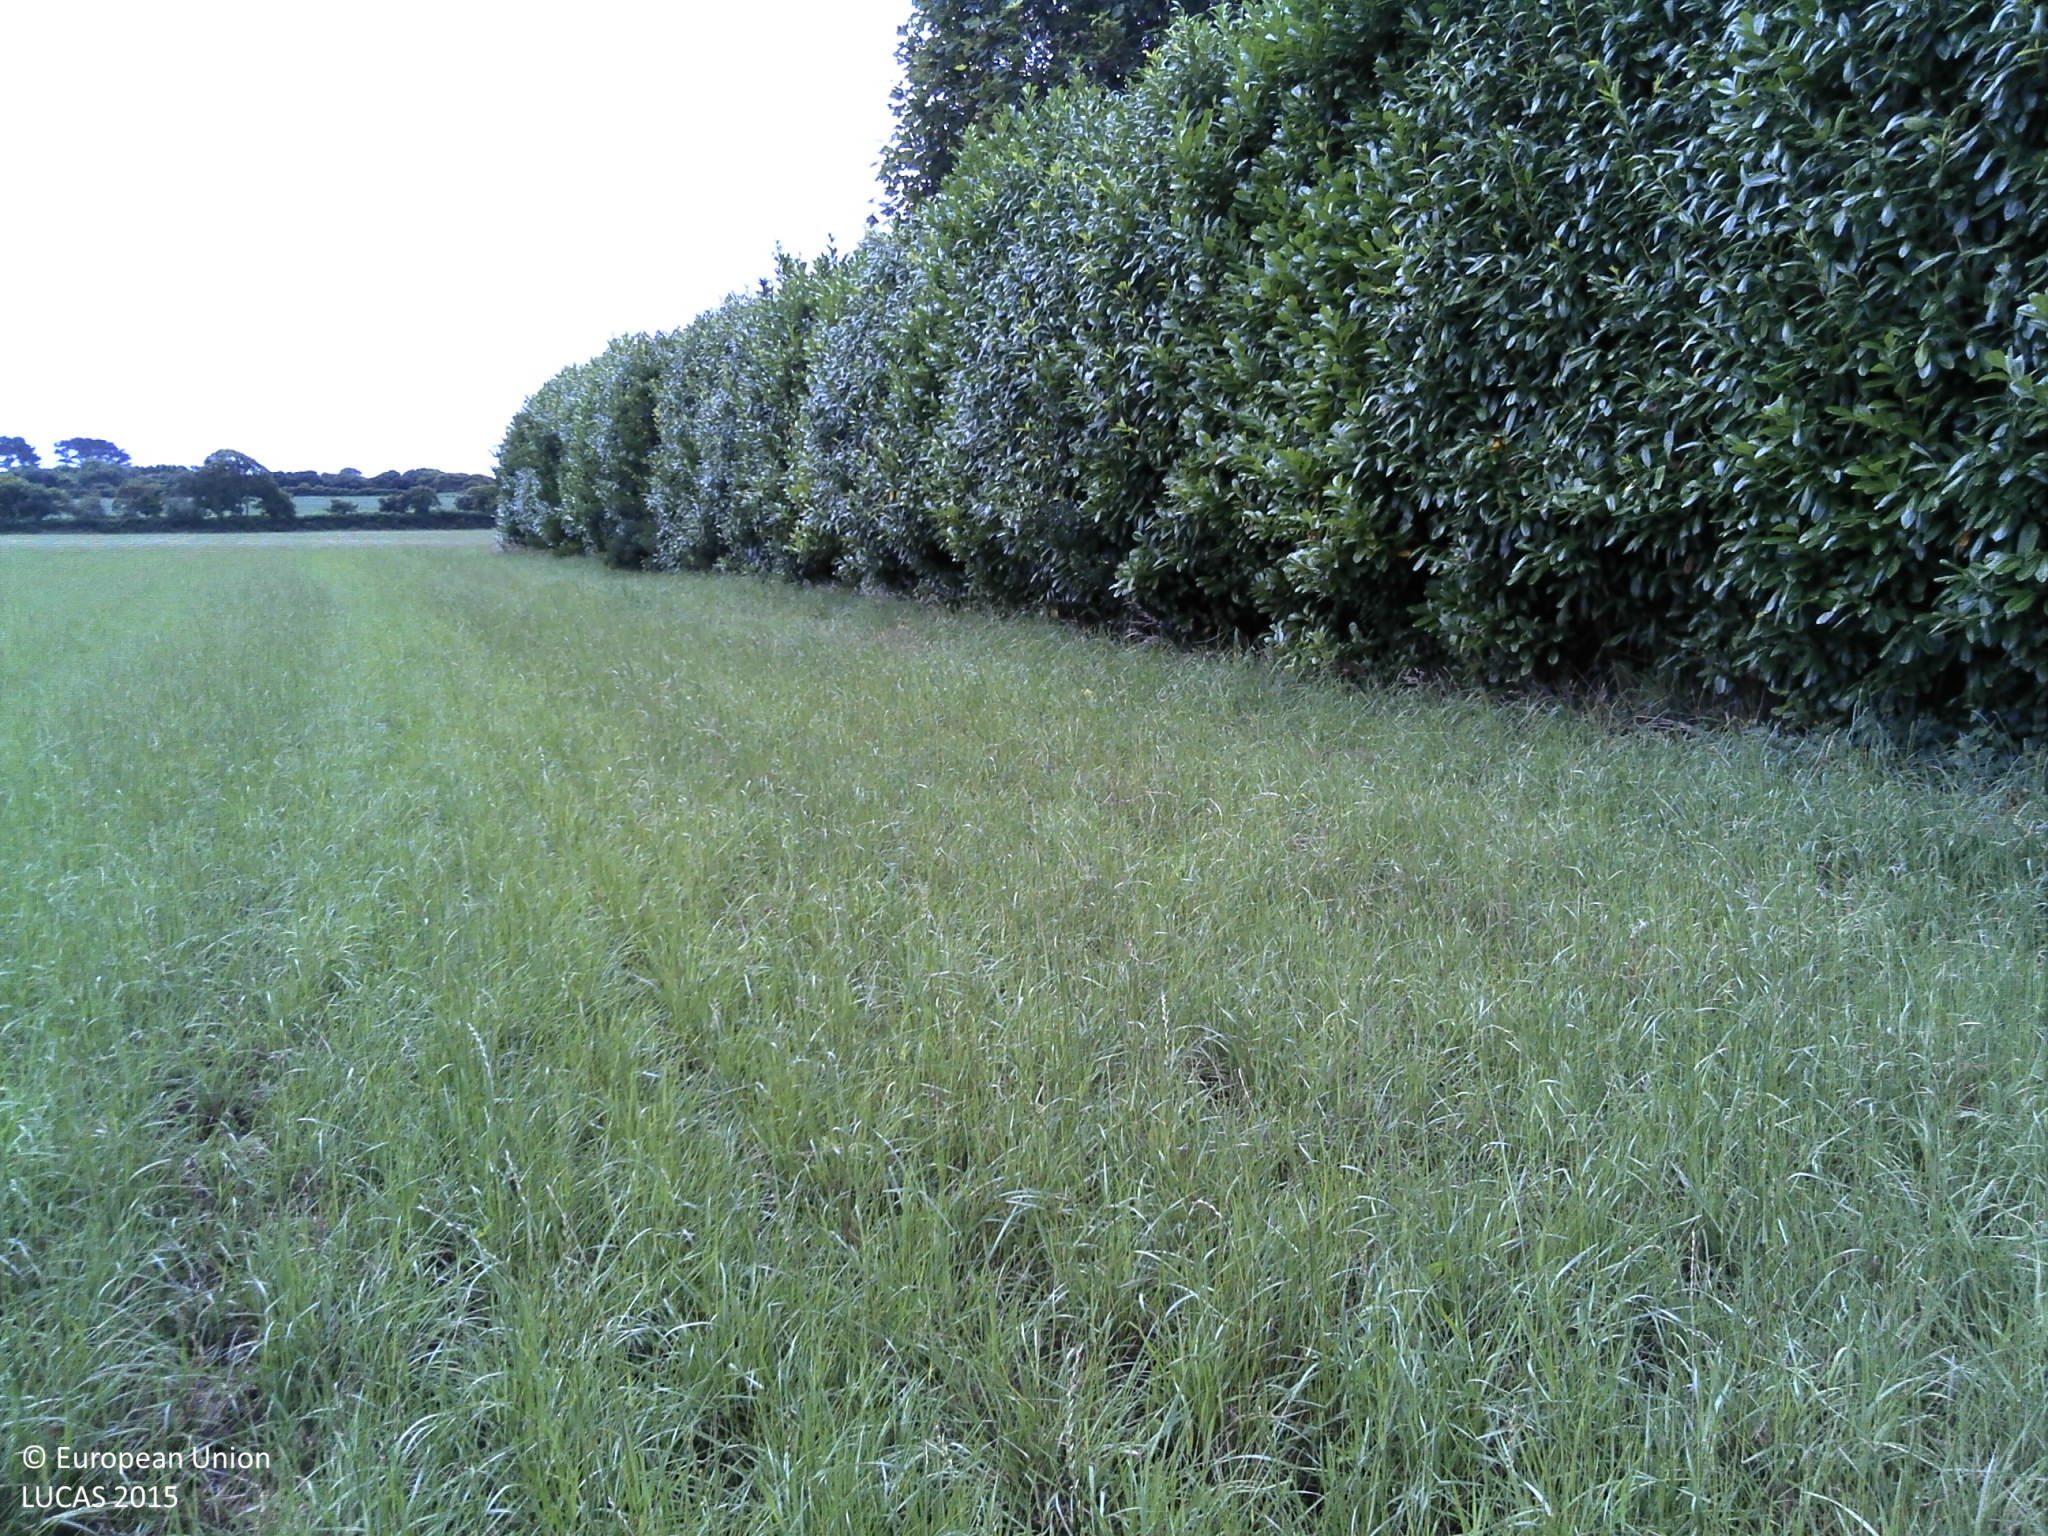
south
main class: Cropland
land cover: Temporary grasslands
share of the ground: > 75 %
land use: Agriculture (excluding fallow land and kitchen gardens)
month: July
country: FR
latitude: 48.4187
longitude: -4.5718
